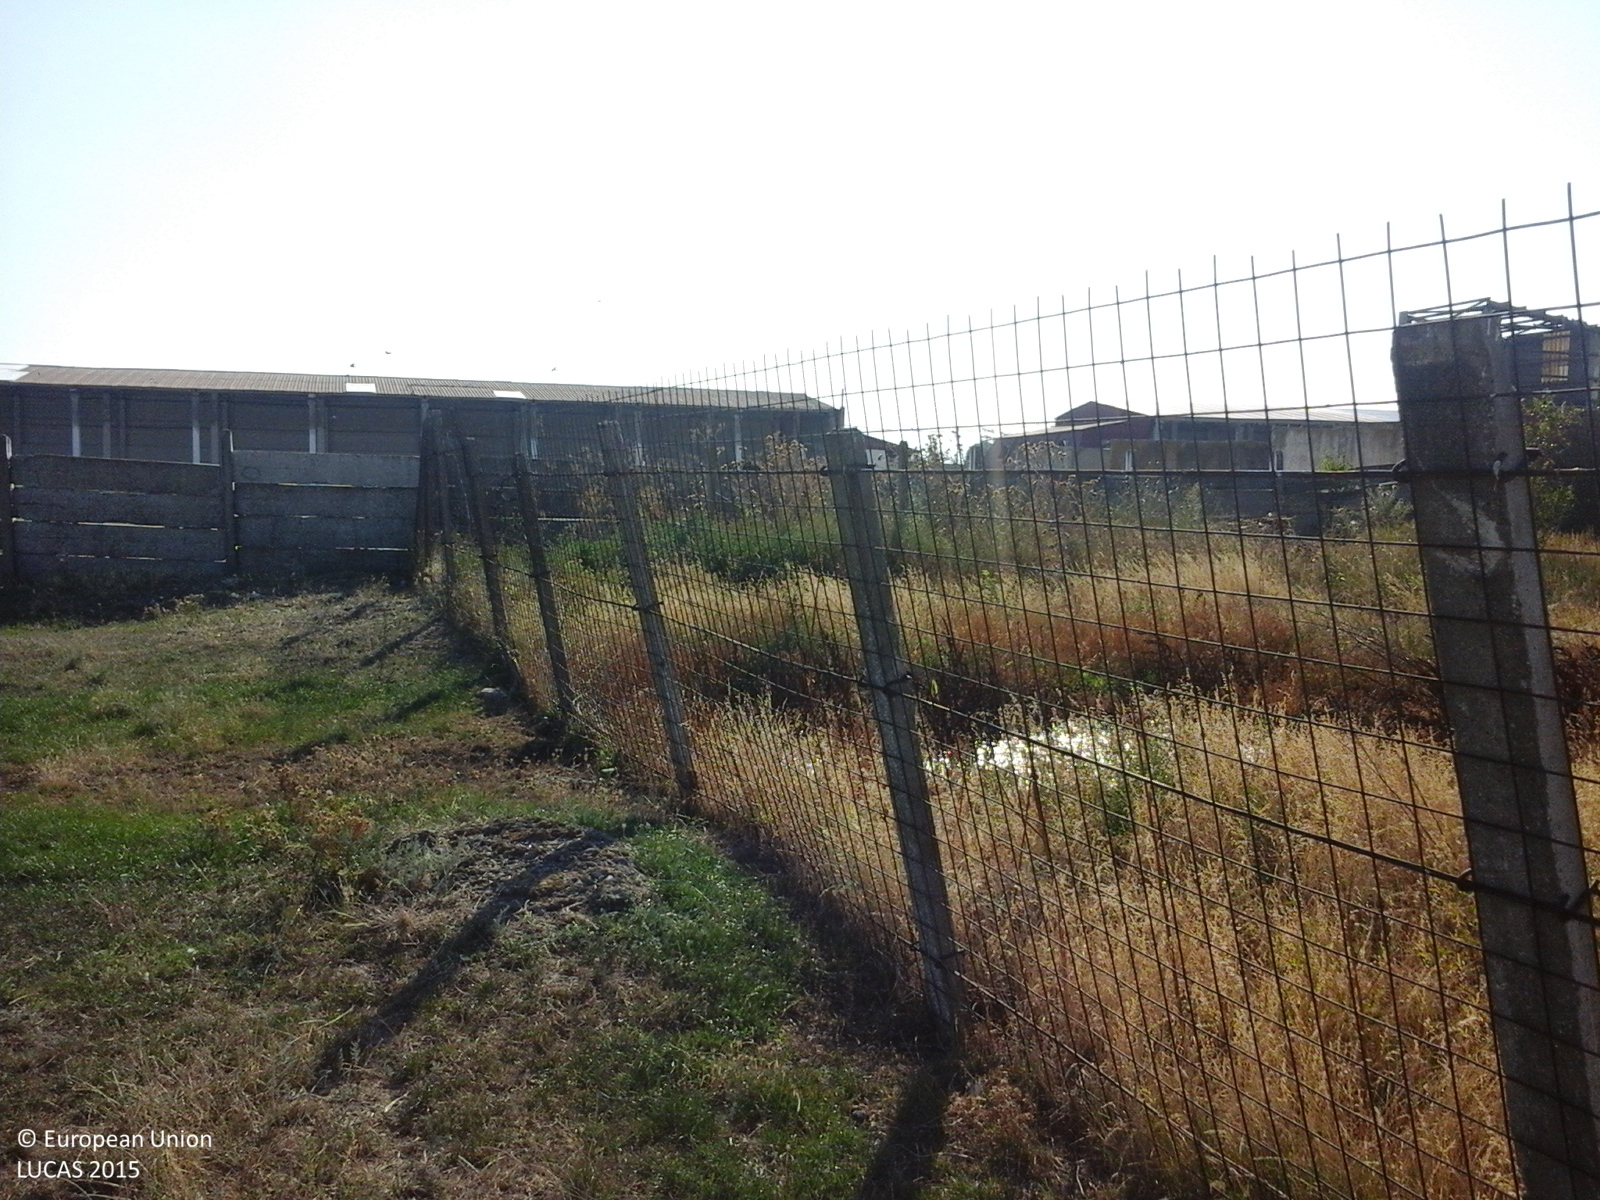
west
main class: Grassland
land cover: Spontaneously vegetated surfaces
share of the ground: > 75 %
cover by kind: herbaceous plants 100 %
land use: Agriculture (excluding fallow land and kitchen gardens)
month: July
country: RO
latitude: 44.9702
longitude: 27.3756
